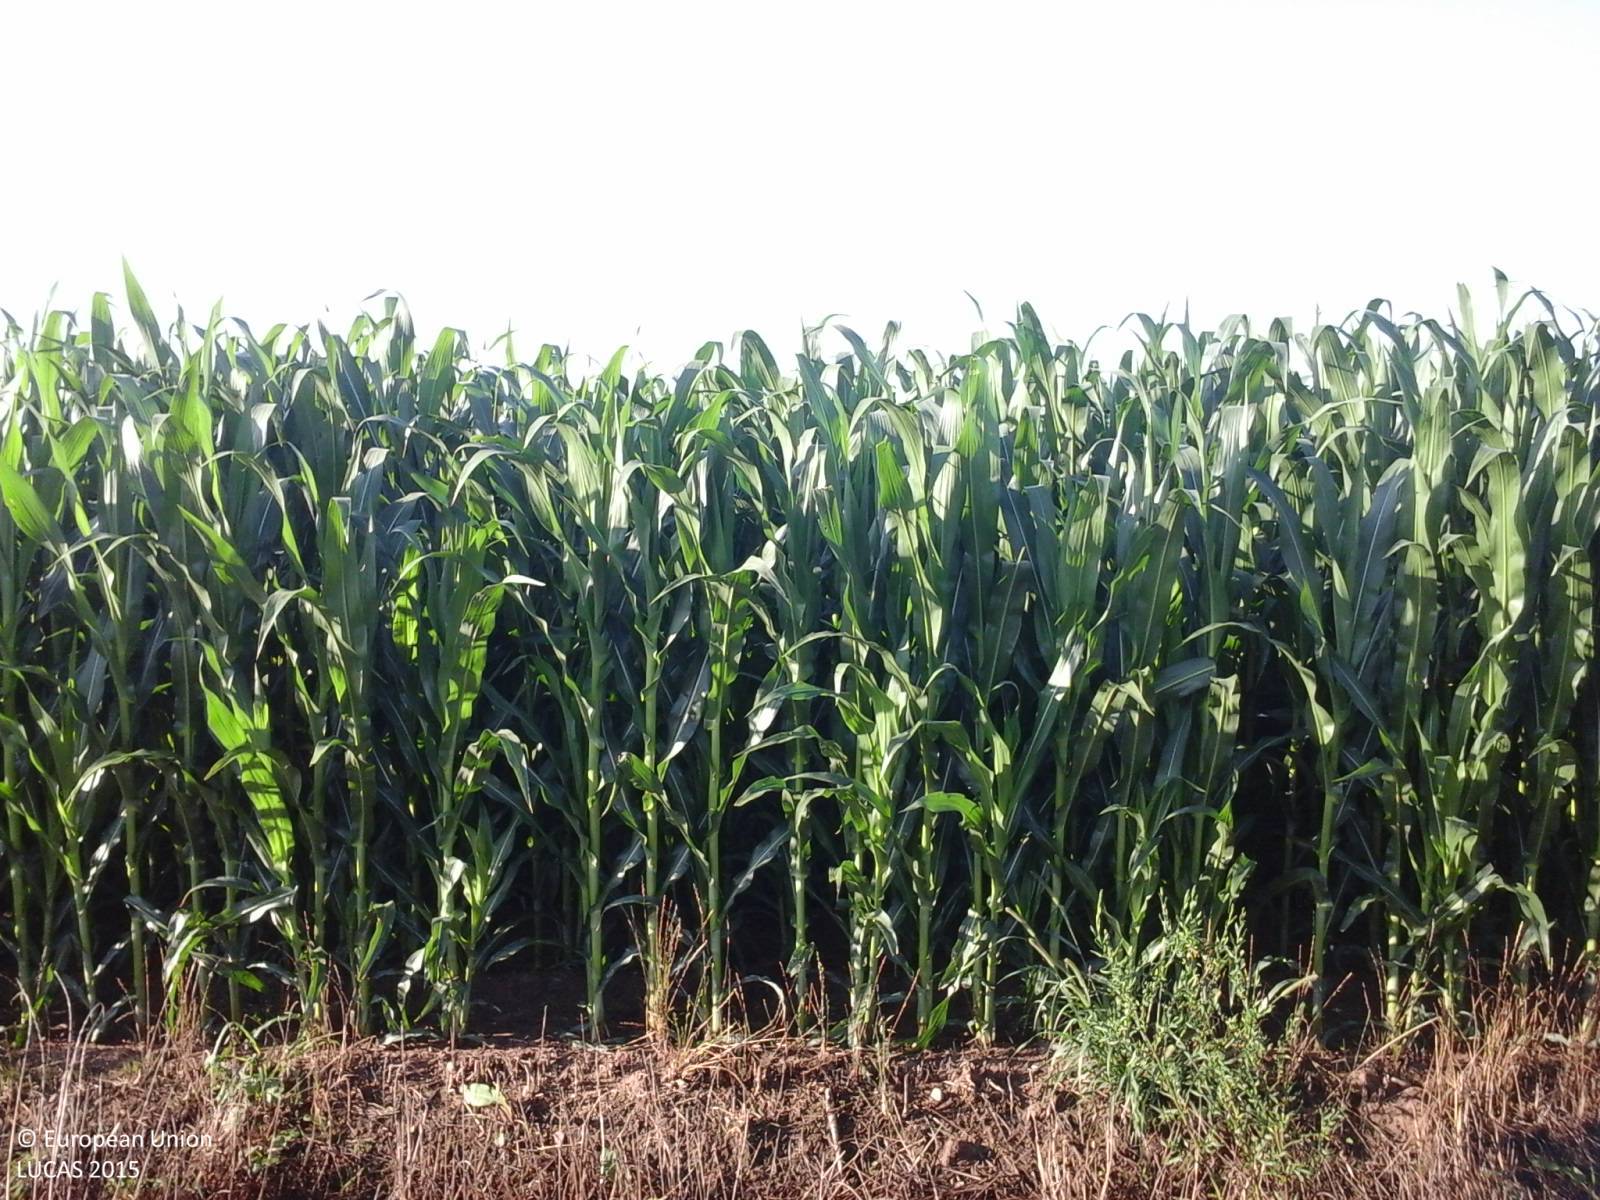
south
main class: Cropland
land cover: Maize
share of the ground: > 75 %
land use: Agriculture (excluding fallow land and kitchen gardens)
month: July
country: IT
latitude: 40.6227
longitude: 8.8590
